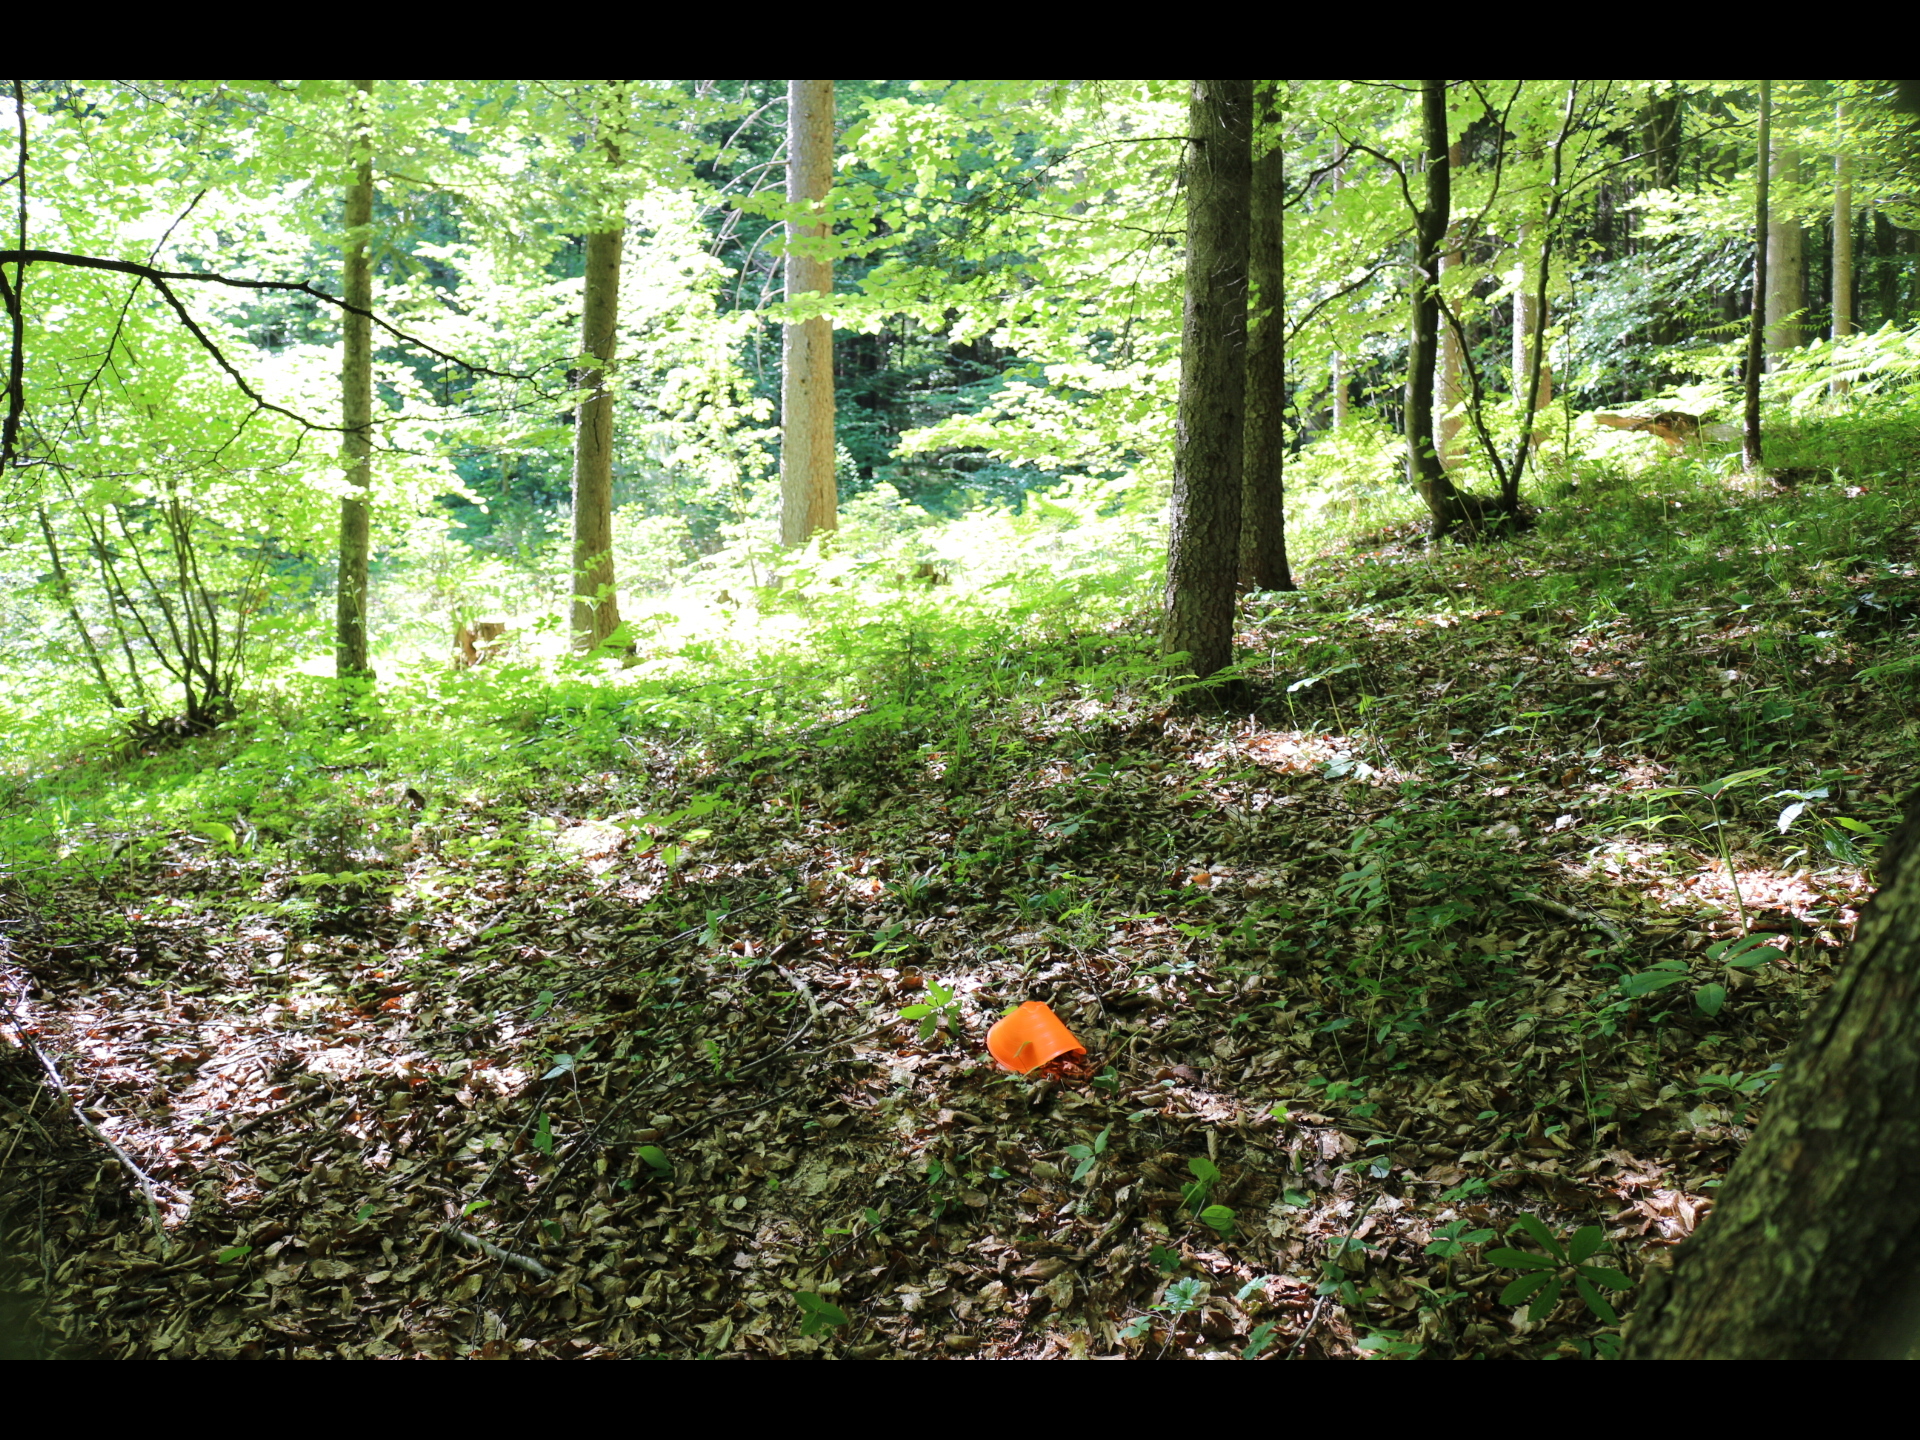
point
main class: Woodland
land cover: Spruce dominated mixed woodland
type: mountainous beech forest
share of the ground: > 75 %
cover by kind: coniferous forest trees 60 %, broadleaved forest trees 40 %
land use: Forestry
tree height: > 5 m
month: May
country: AT
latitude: 46.5168
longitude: 14.3116
